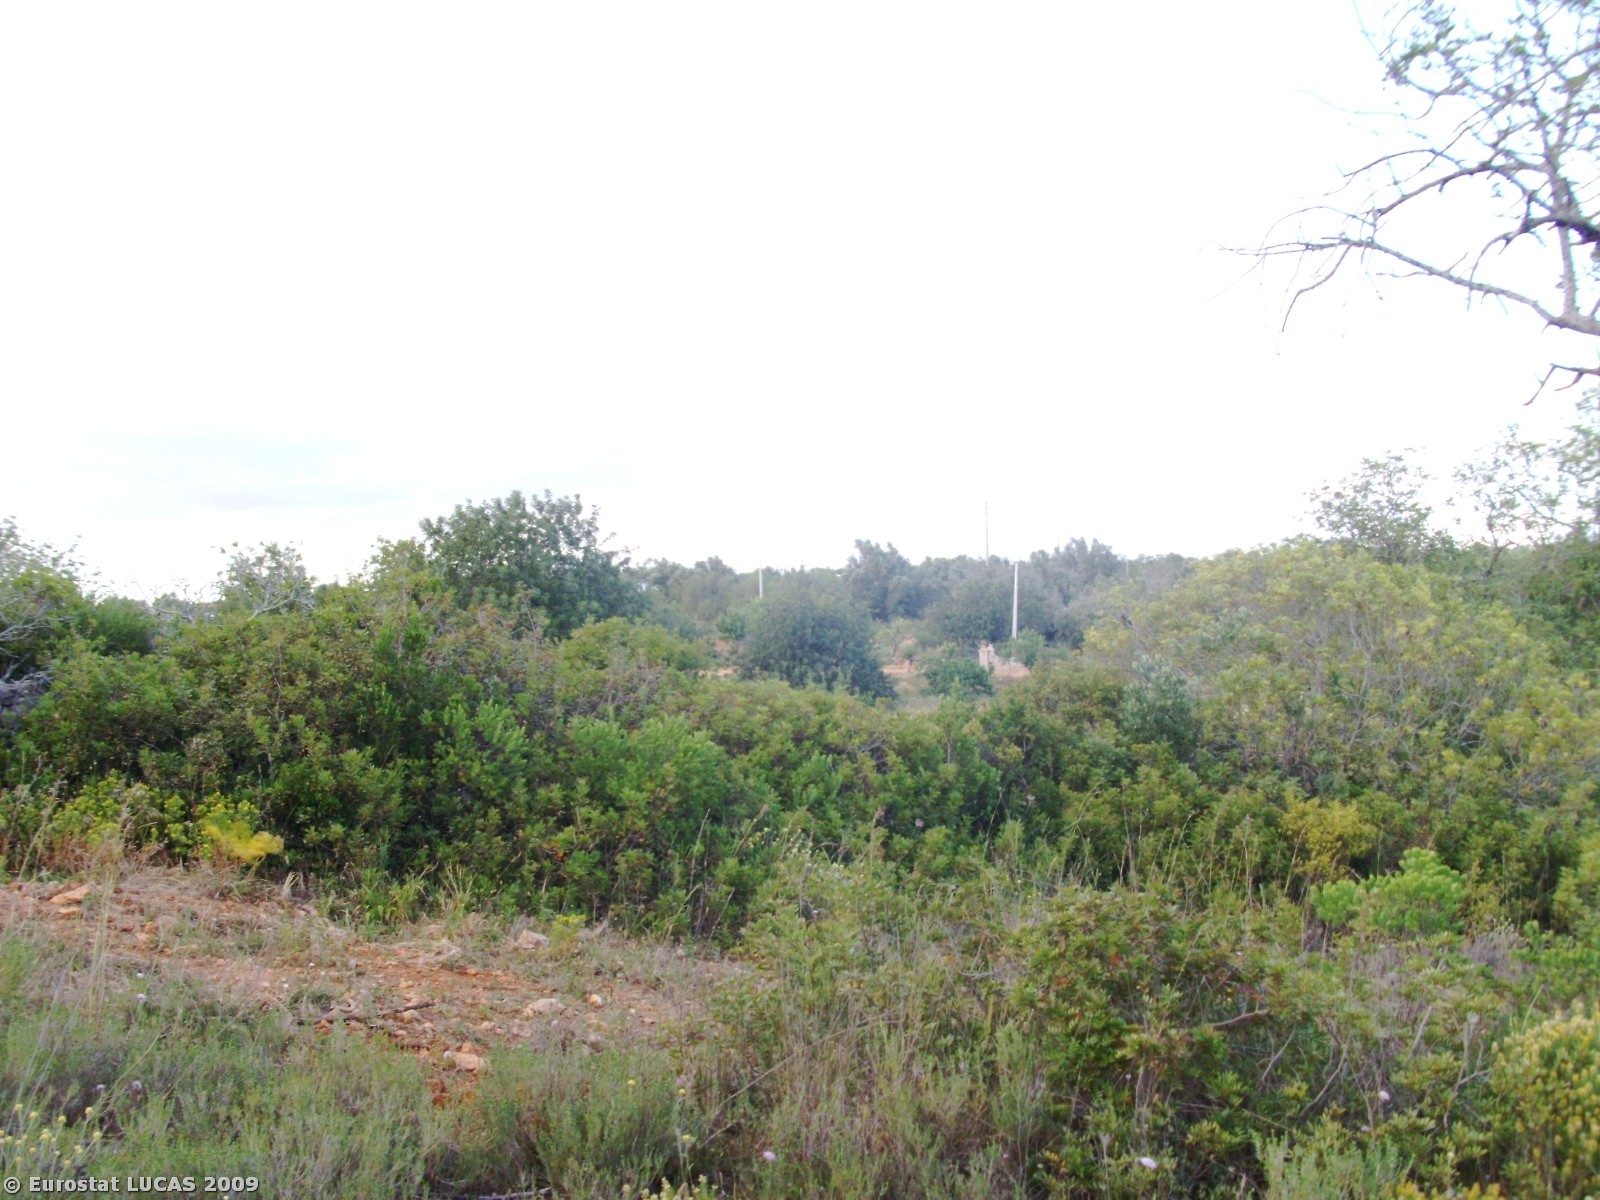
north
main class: Shrubland
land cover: Shrubland with sparse tree cover
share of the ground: > 75 %
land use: Fallow land
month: May
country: PT
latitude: 37.1120
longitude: -8.2602
